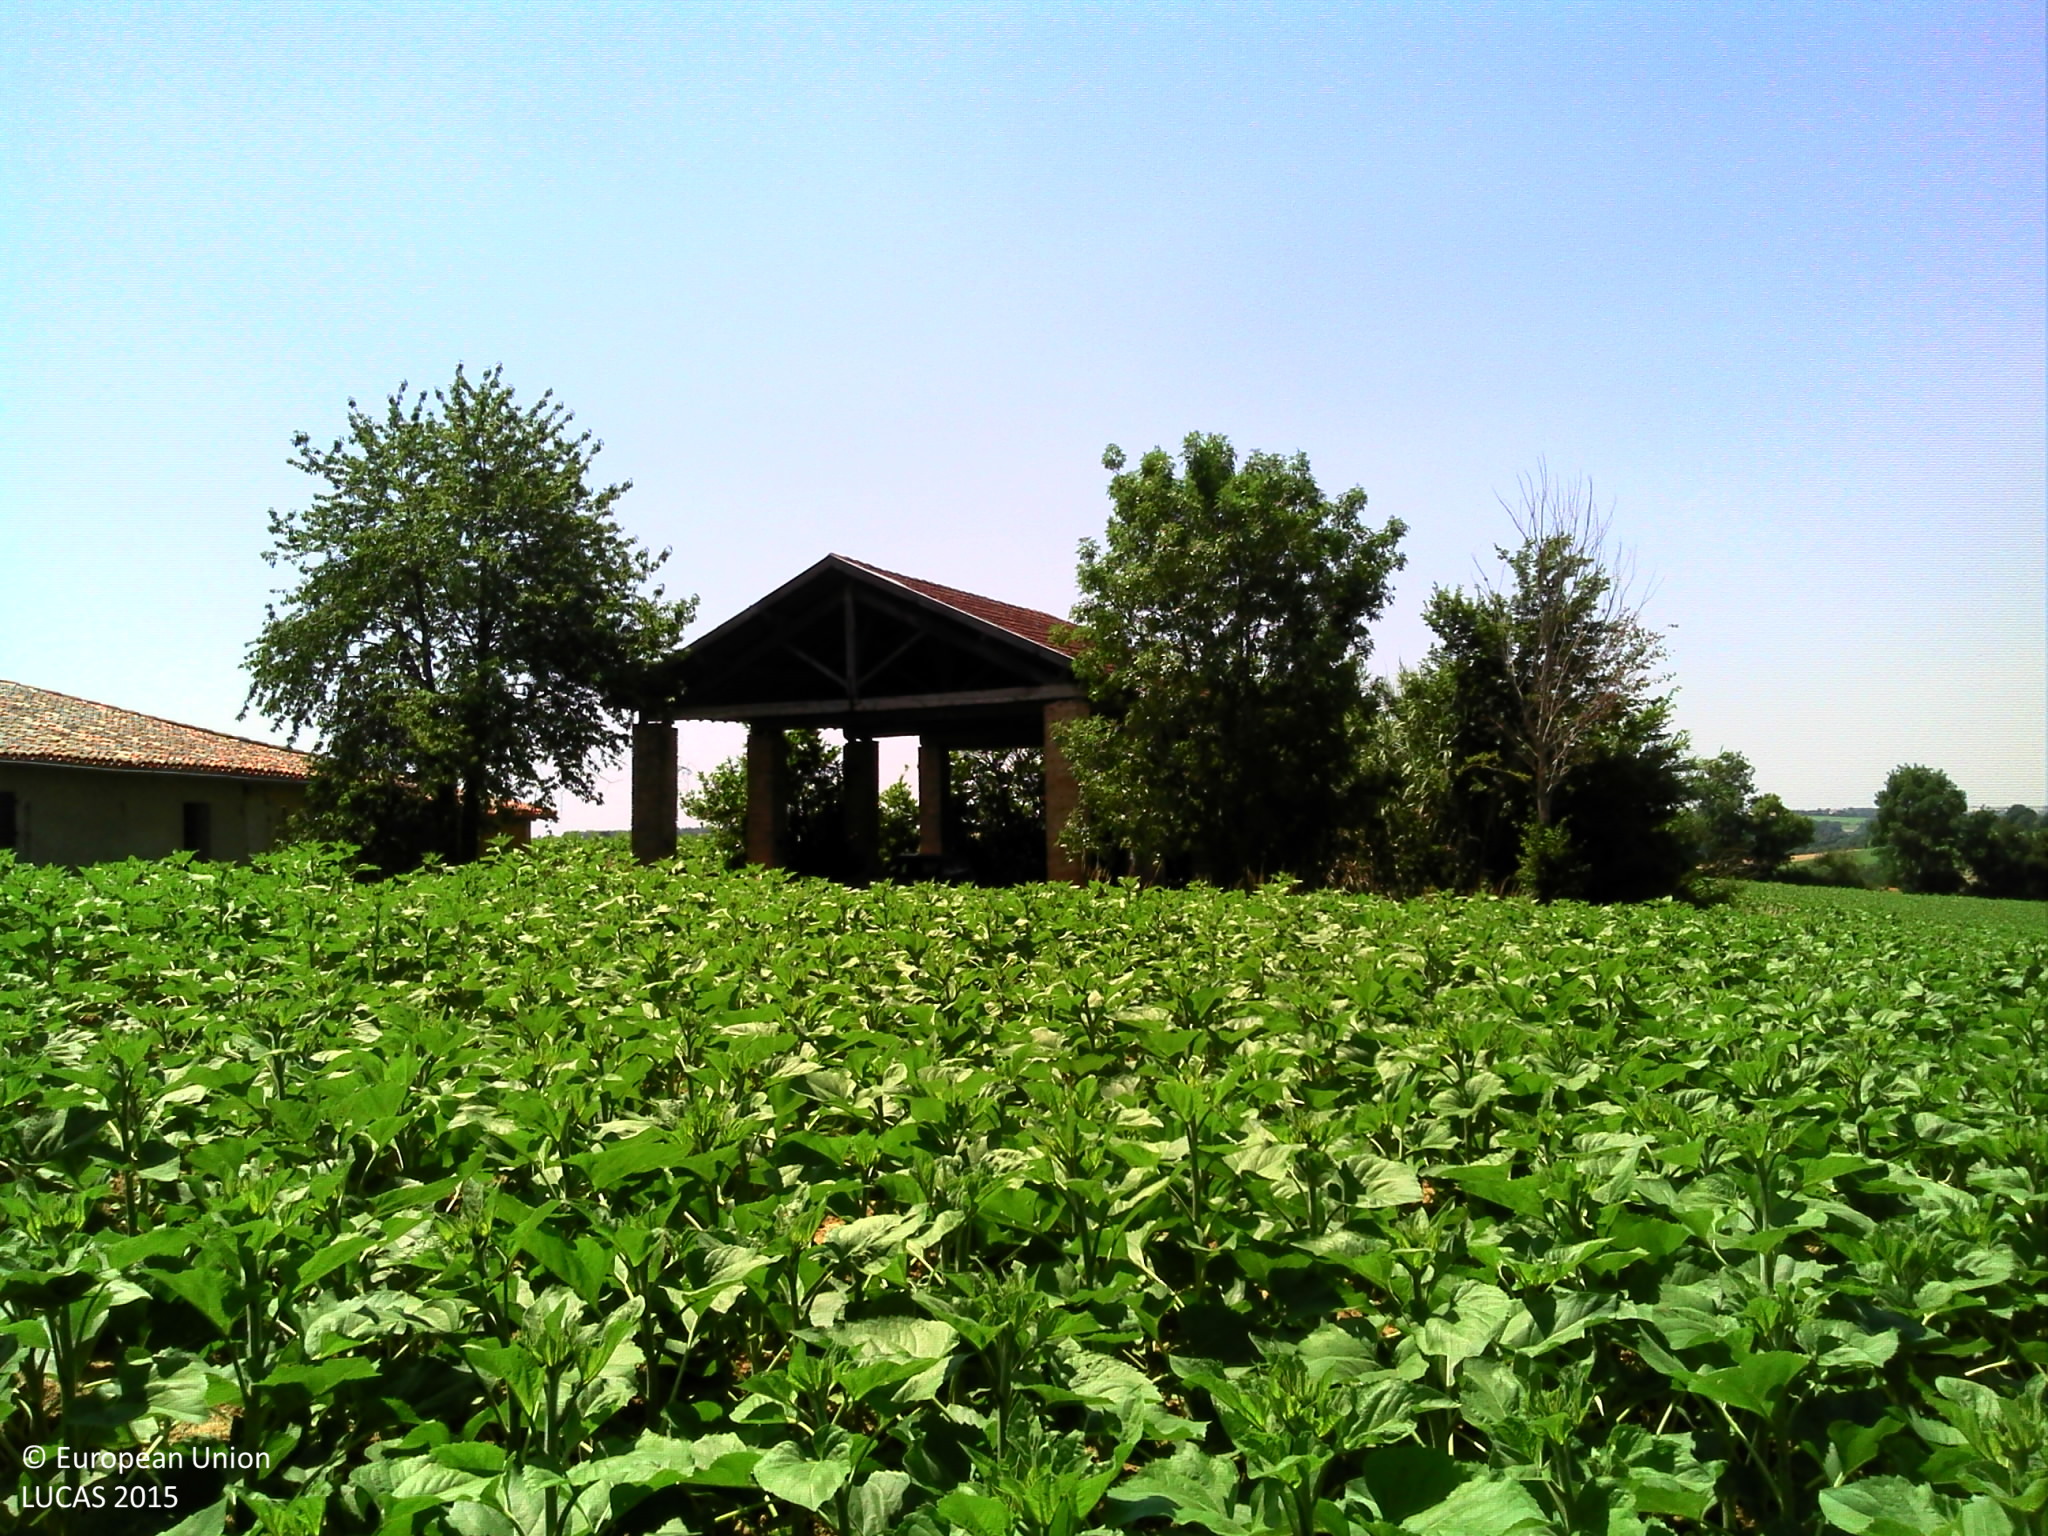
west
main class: Cropland
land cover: Sunflower
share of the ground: > 75 %
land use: Agriculture (excluding fallow land and kitchen gardens)
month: June
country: FR
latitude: 43.7251
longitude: 1.0247
